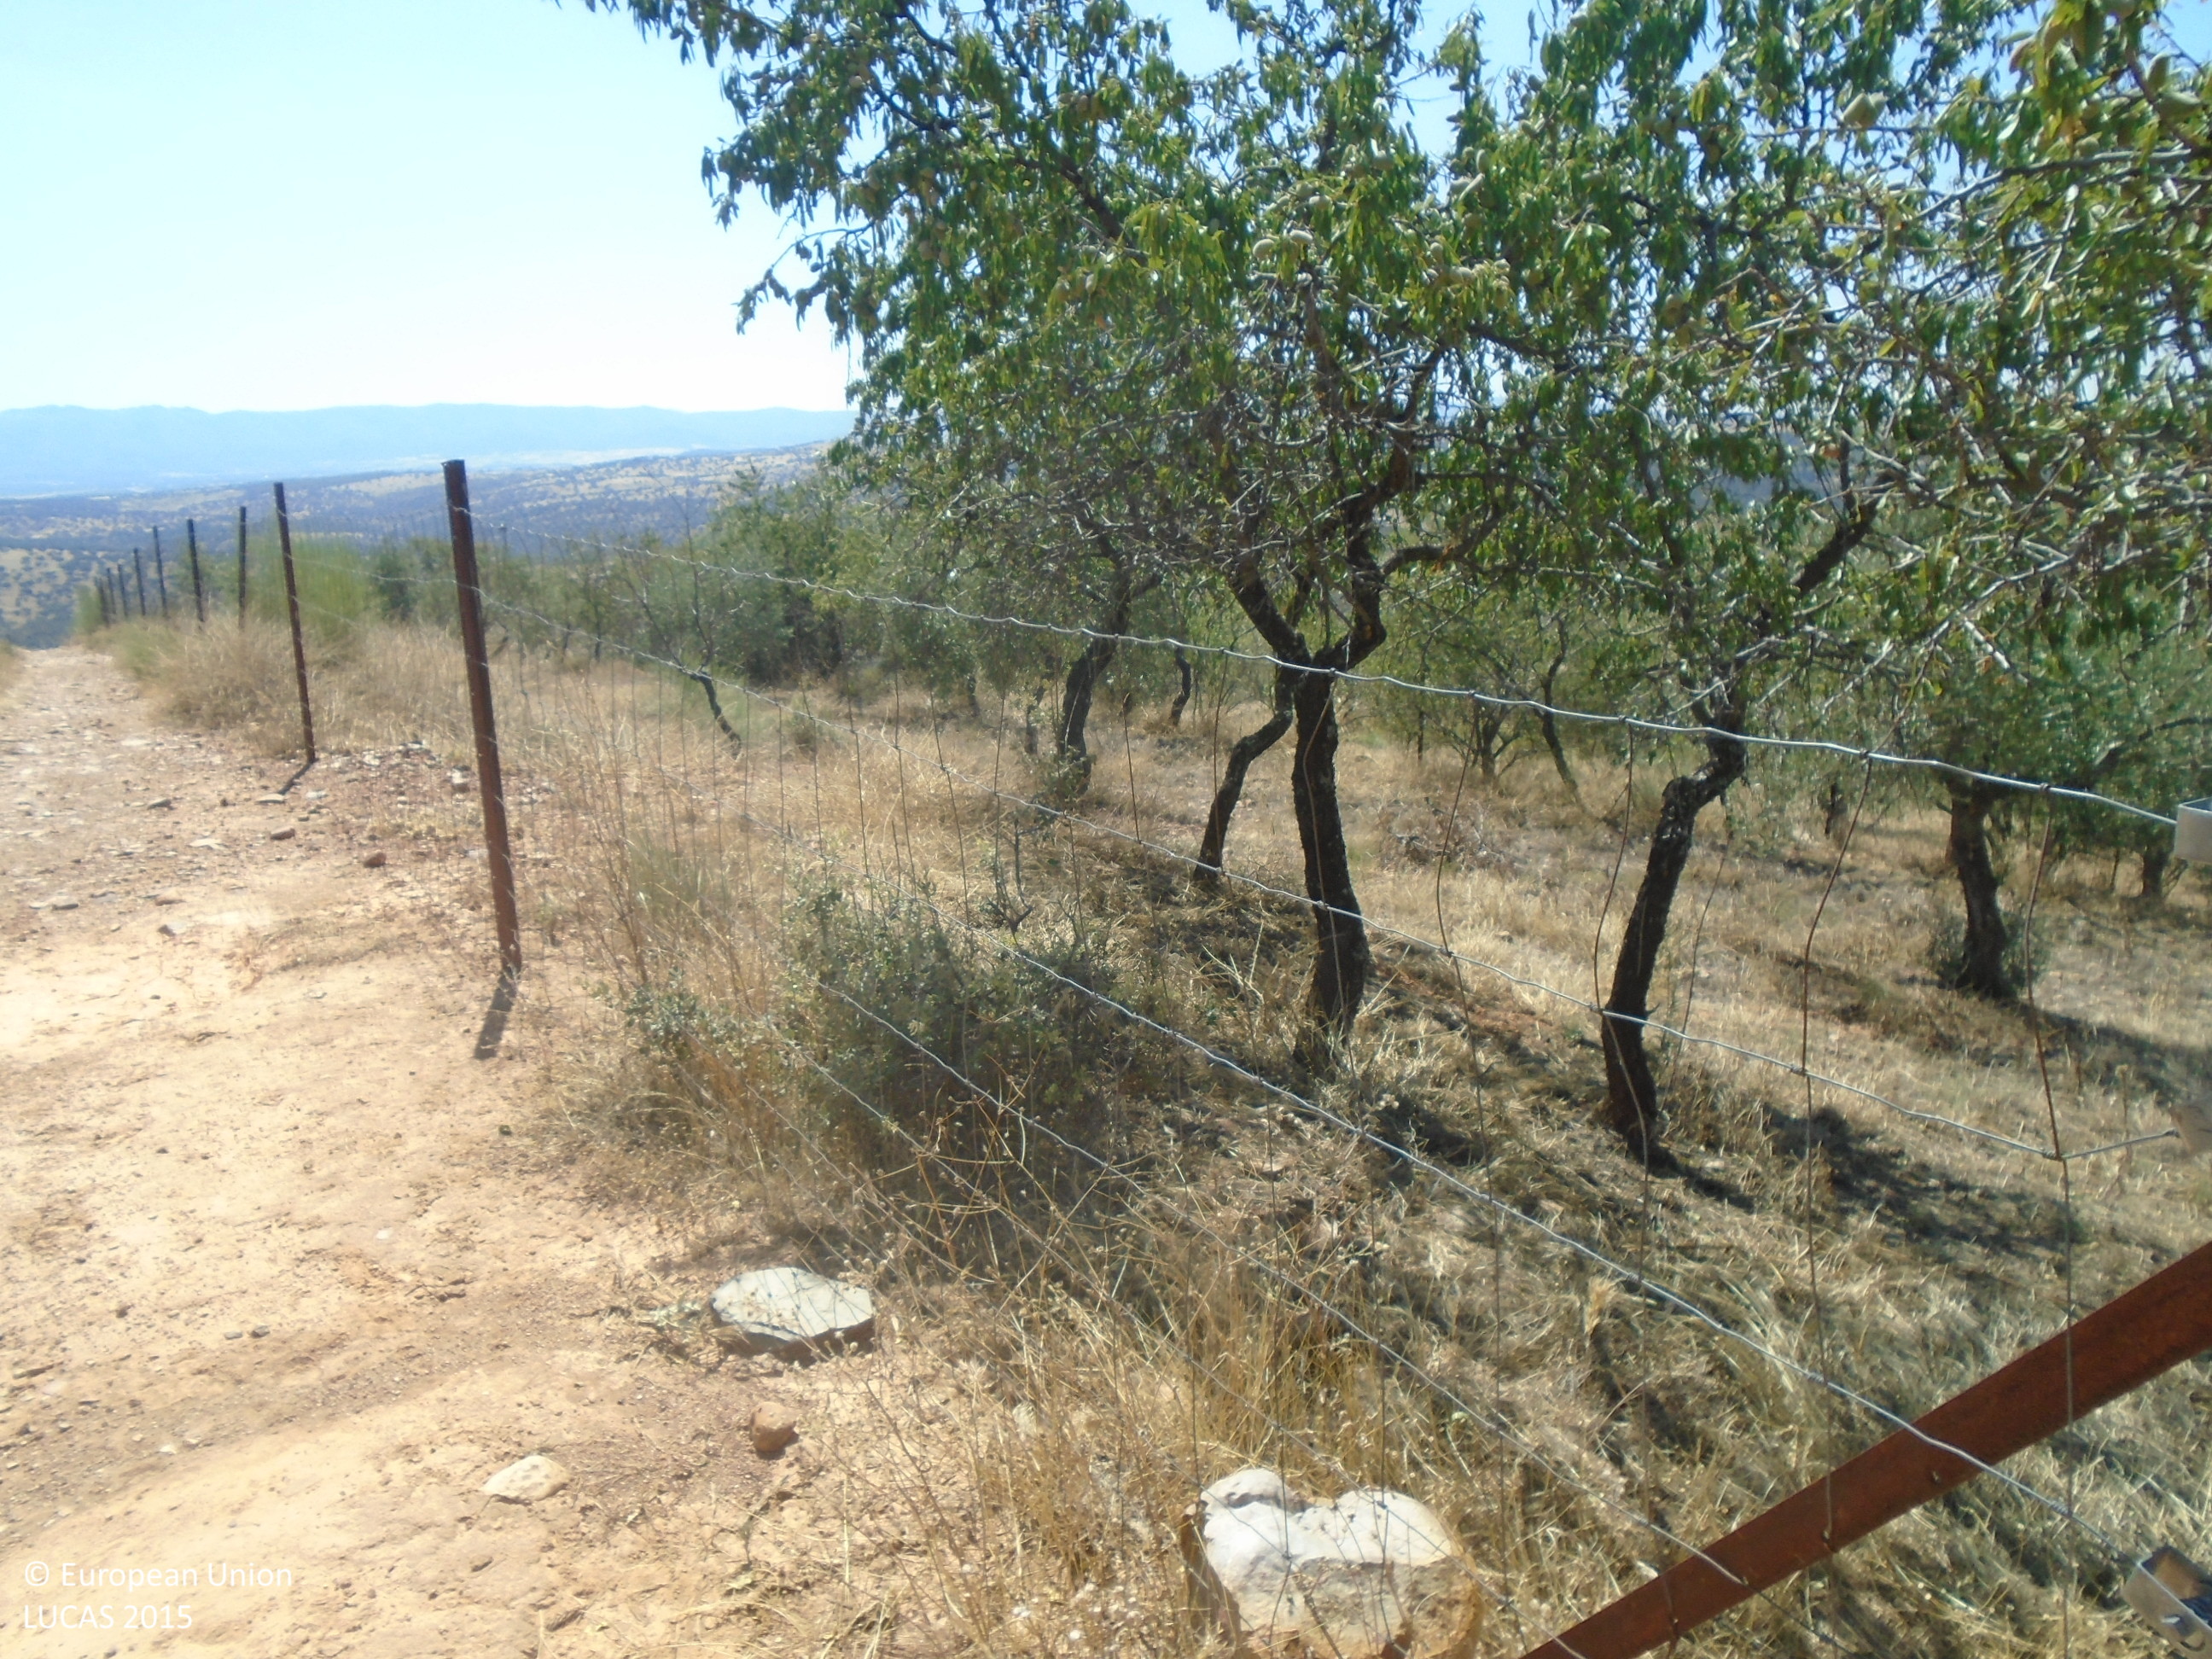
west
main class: Cropland
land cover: Olive groves
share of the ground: 10 - 25 %
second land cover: Spontaneously vegetated surfaces
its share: > 75 %
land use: Agriculture (excluding fallow land and kitchen gardens)
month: July
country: ES
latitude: 39.6543
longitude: -5.0226
